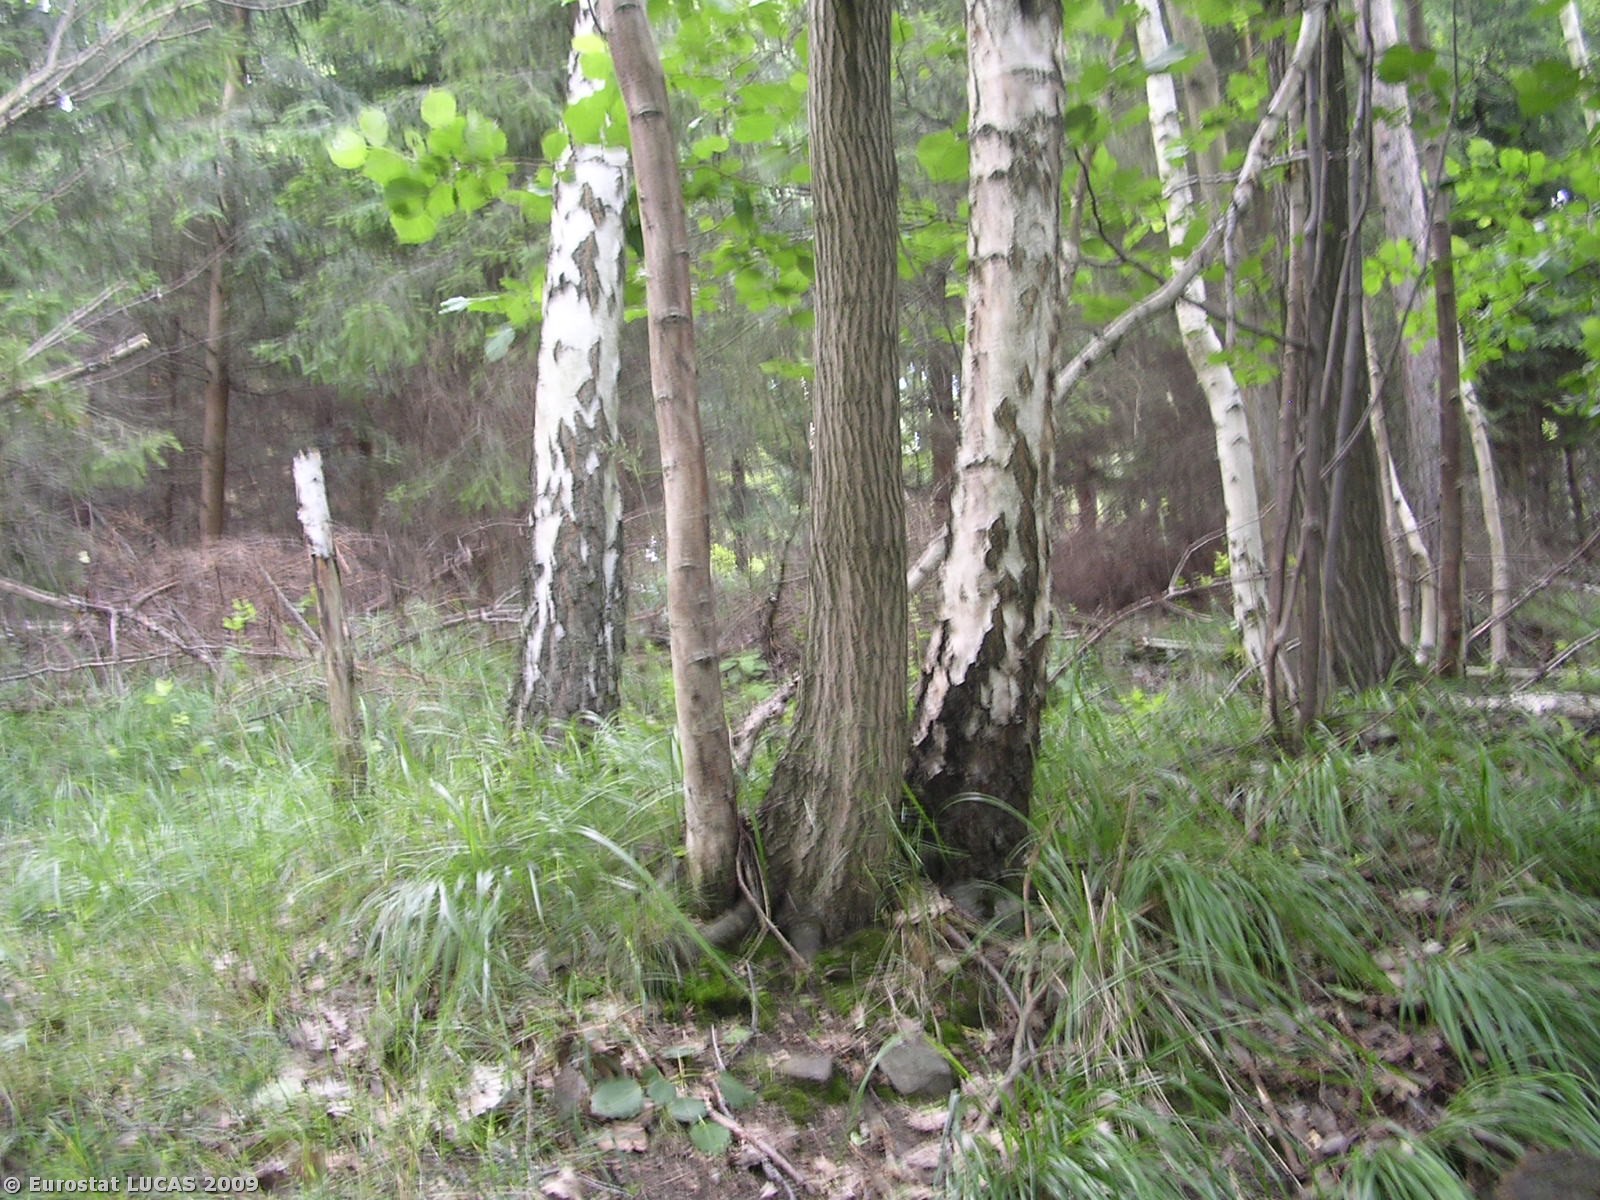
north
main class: Woodland
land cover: Broadleaved woodland
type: non-riverine alder, birch or aspen forest
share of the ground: > 75 %
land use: Forestry
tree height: > 5 m
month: June
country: CZ
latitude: 50.5911
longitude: 14.2532
